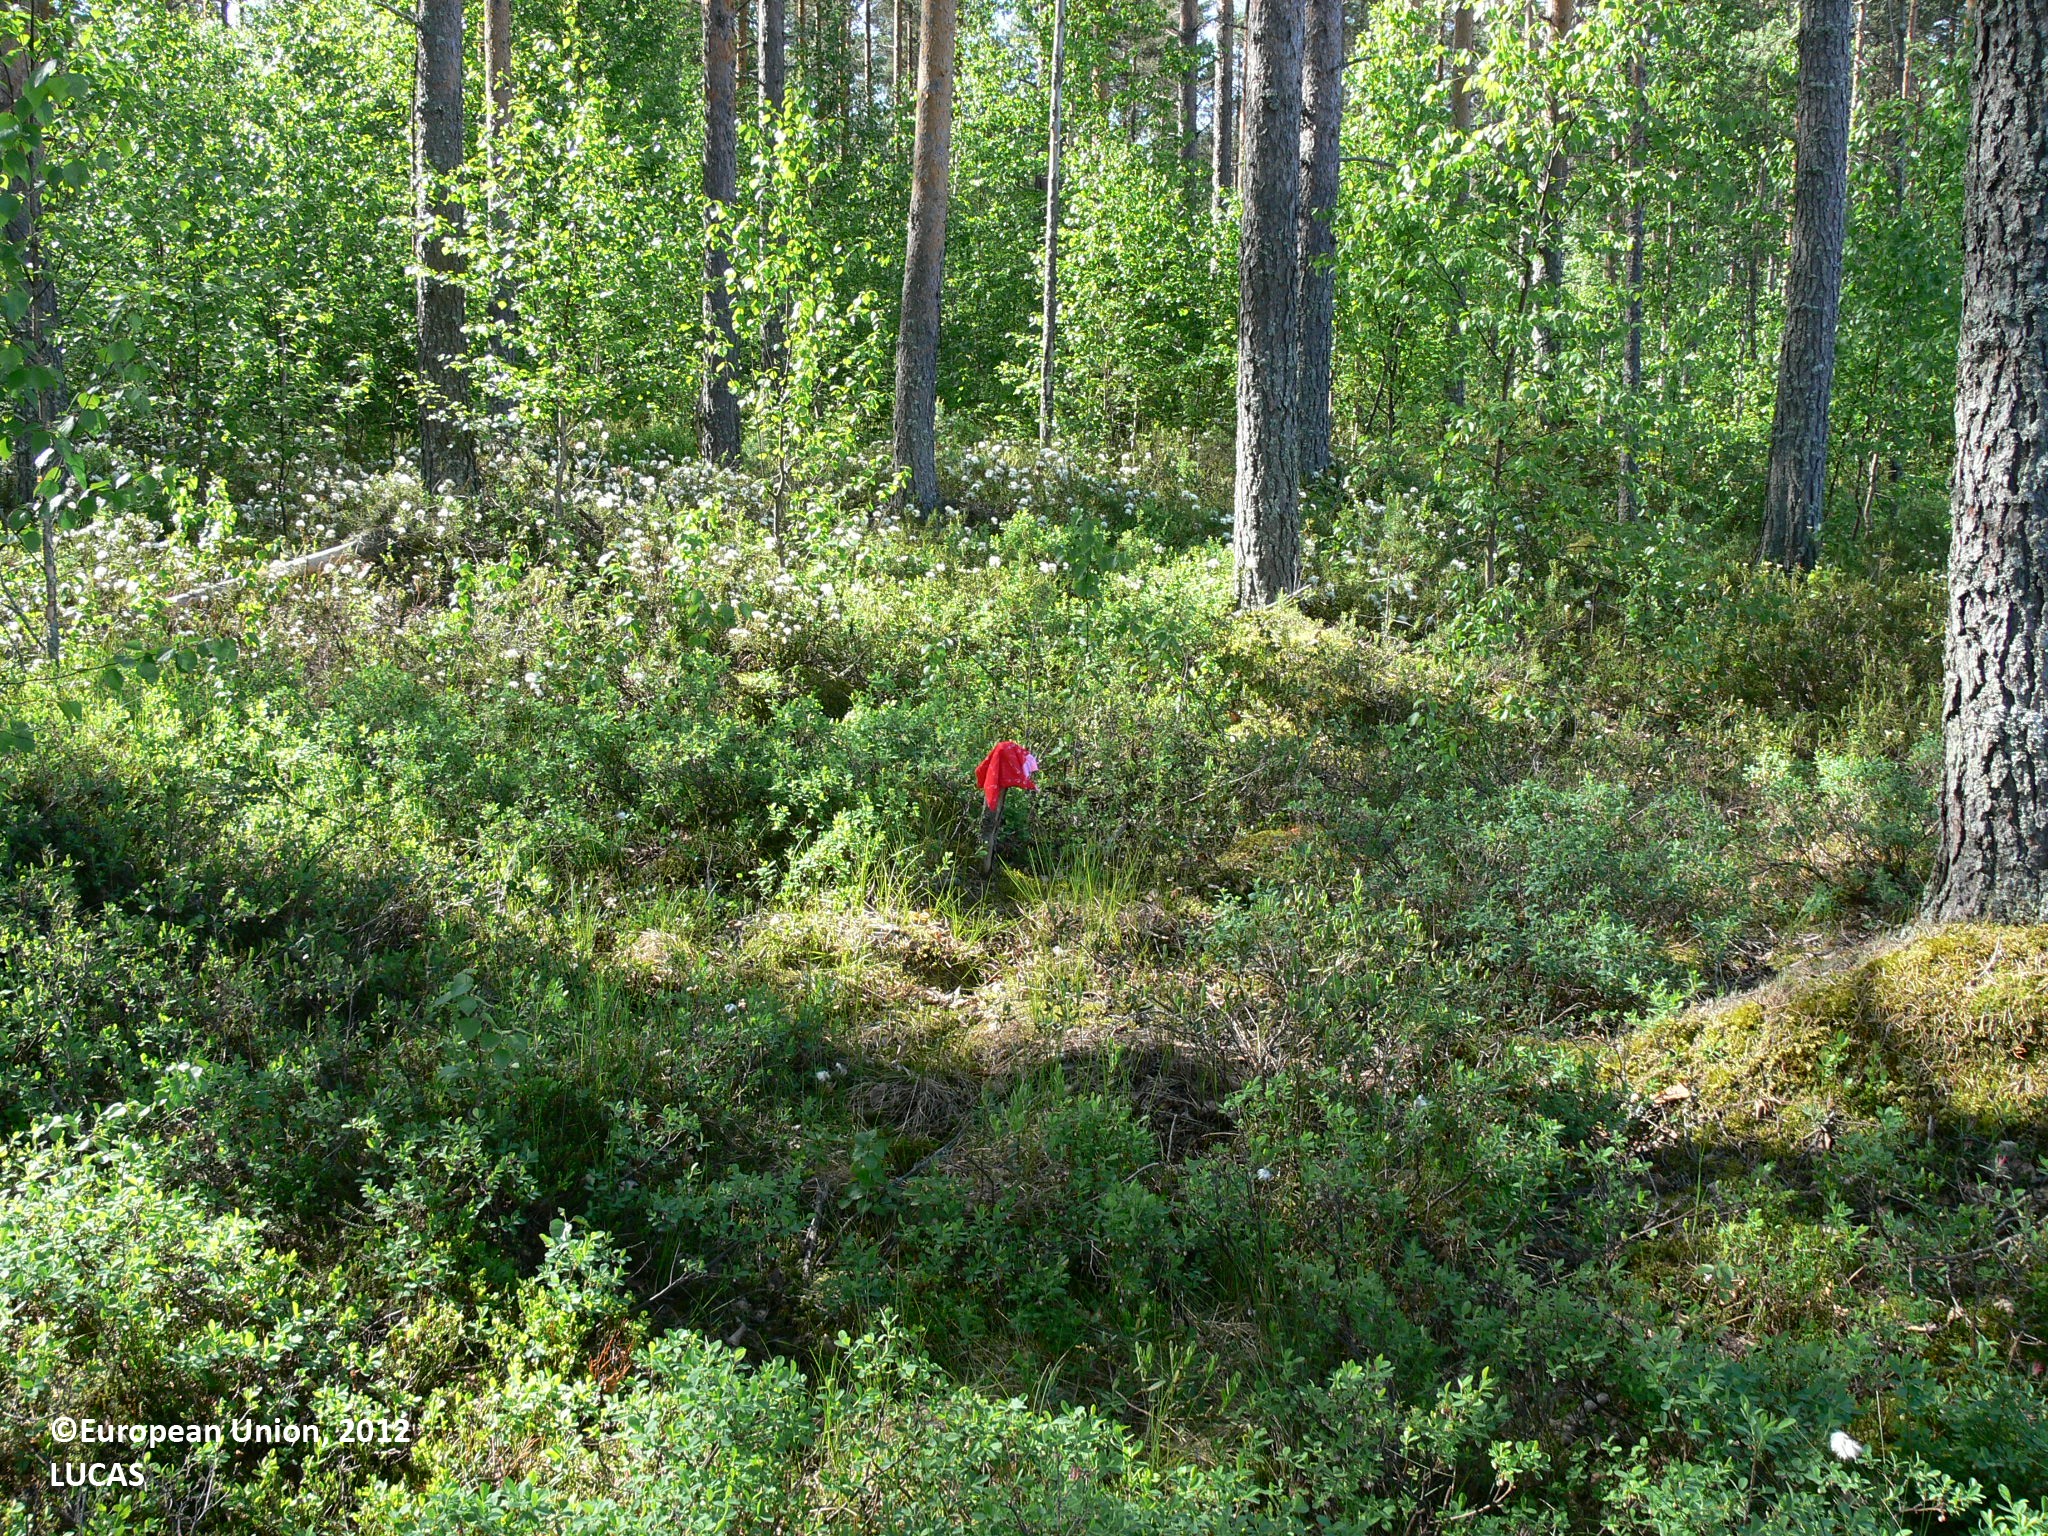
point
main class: Woodland
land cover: Pine dominated coniferous woodland
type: boreal forest
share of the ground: > 75 %
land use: Forestry
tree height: > 5 m
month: June
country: FI
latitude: 62.6683
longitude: 29.8732
